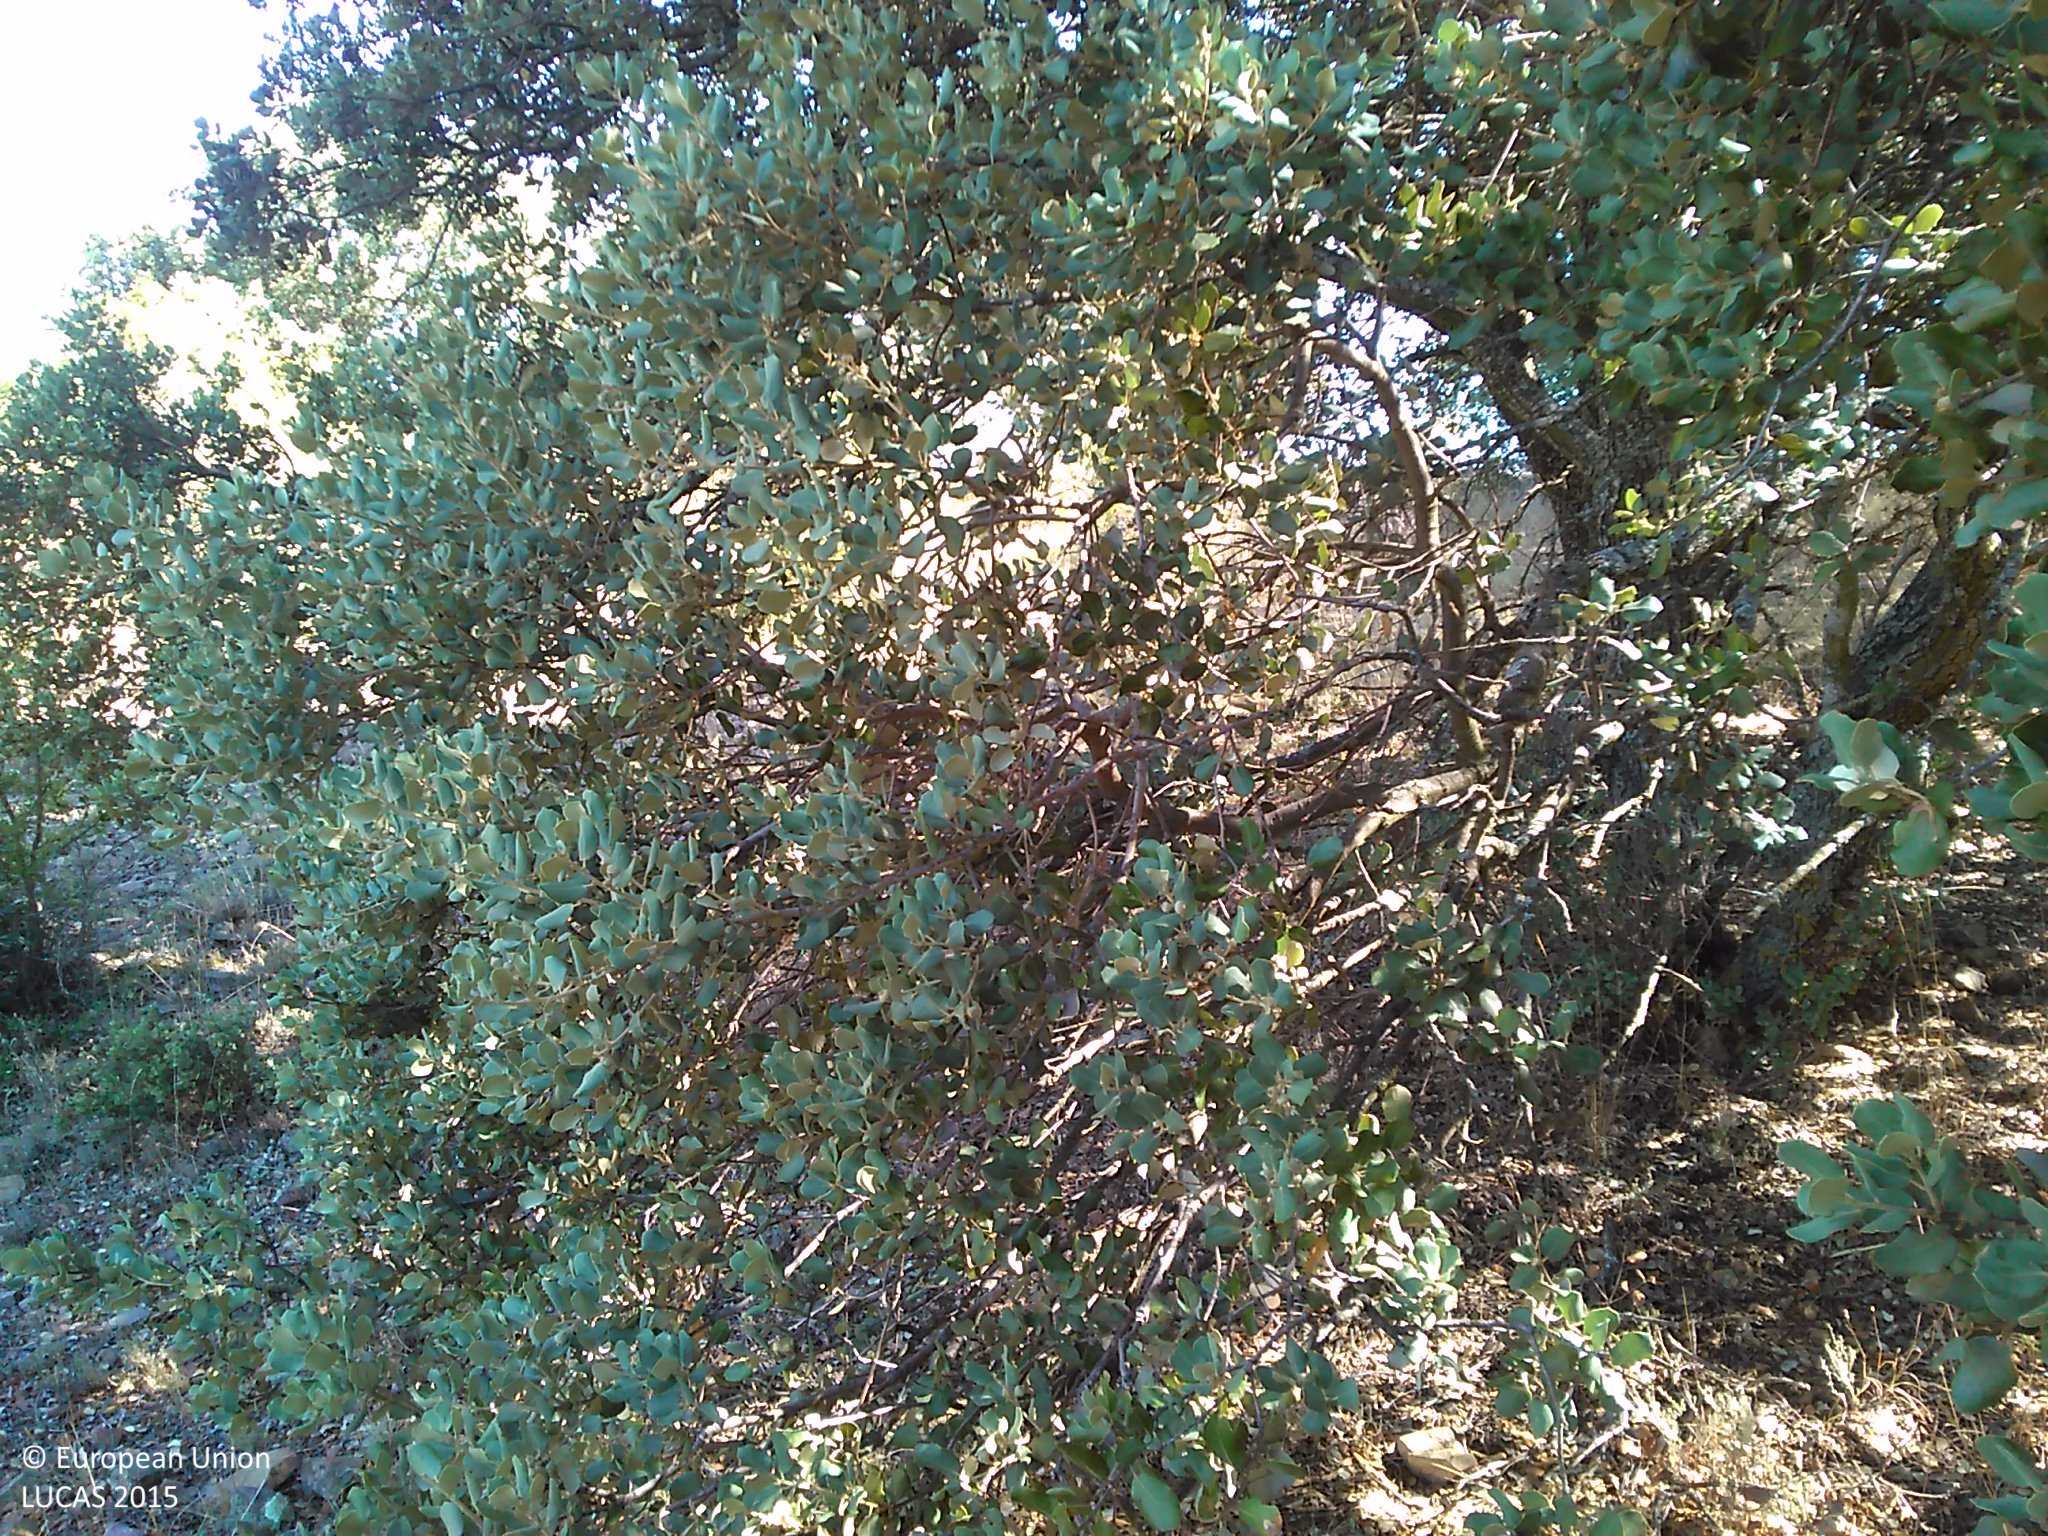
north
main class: Woodland
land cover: Broadleaved woodland
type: broadleaved evergreen forest
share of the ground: 50 - 75 %
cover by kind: broadleaved forest trees 70 %, shrubs 10 %, herbaceous plants 10 %, unconsolidated bare surface 10 %
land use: Semi-natural and natural areas not in use
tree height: > 5 m
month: July
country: ES
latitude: 41.5359
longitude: -2.0047
